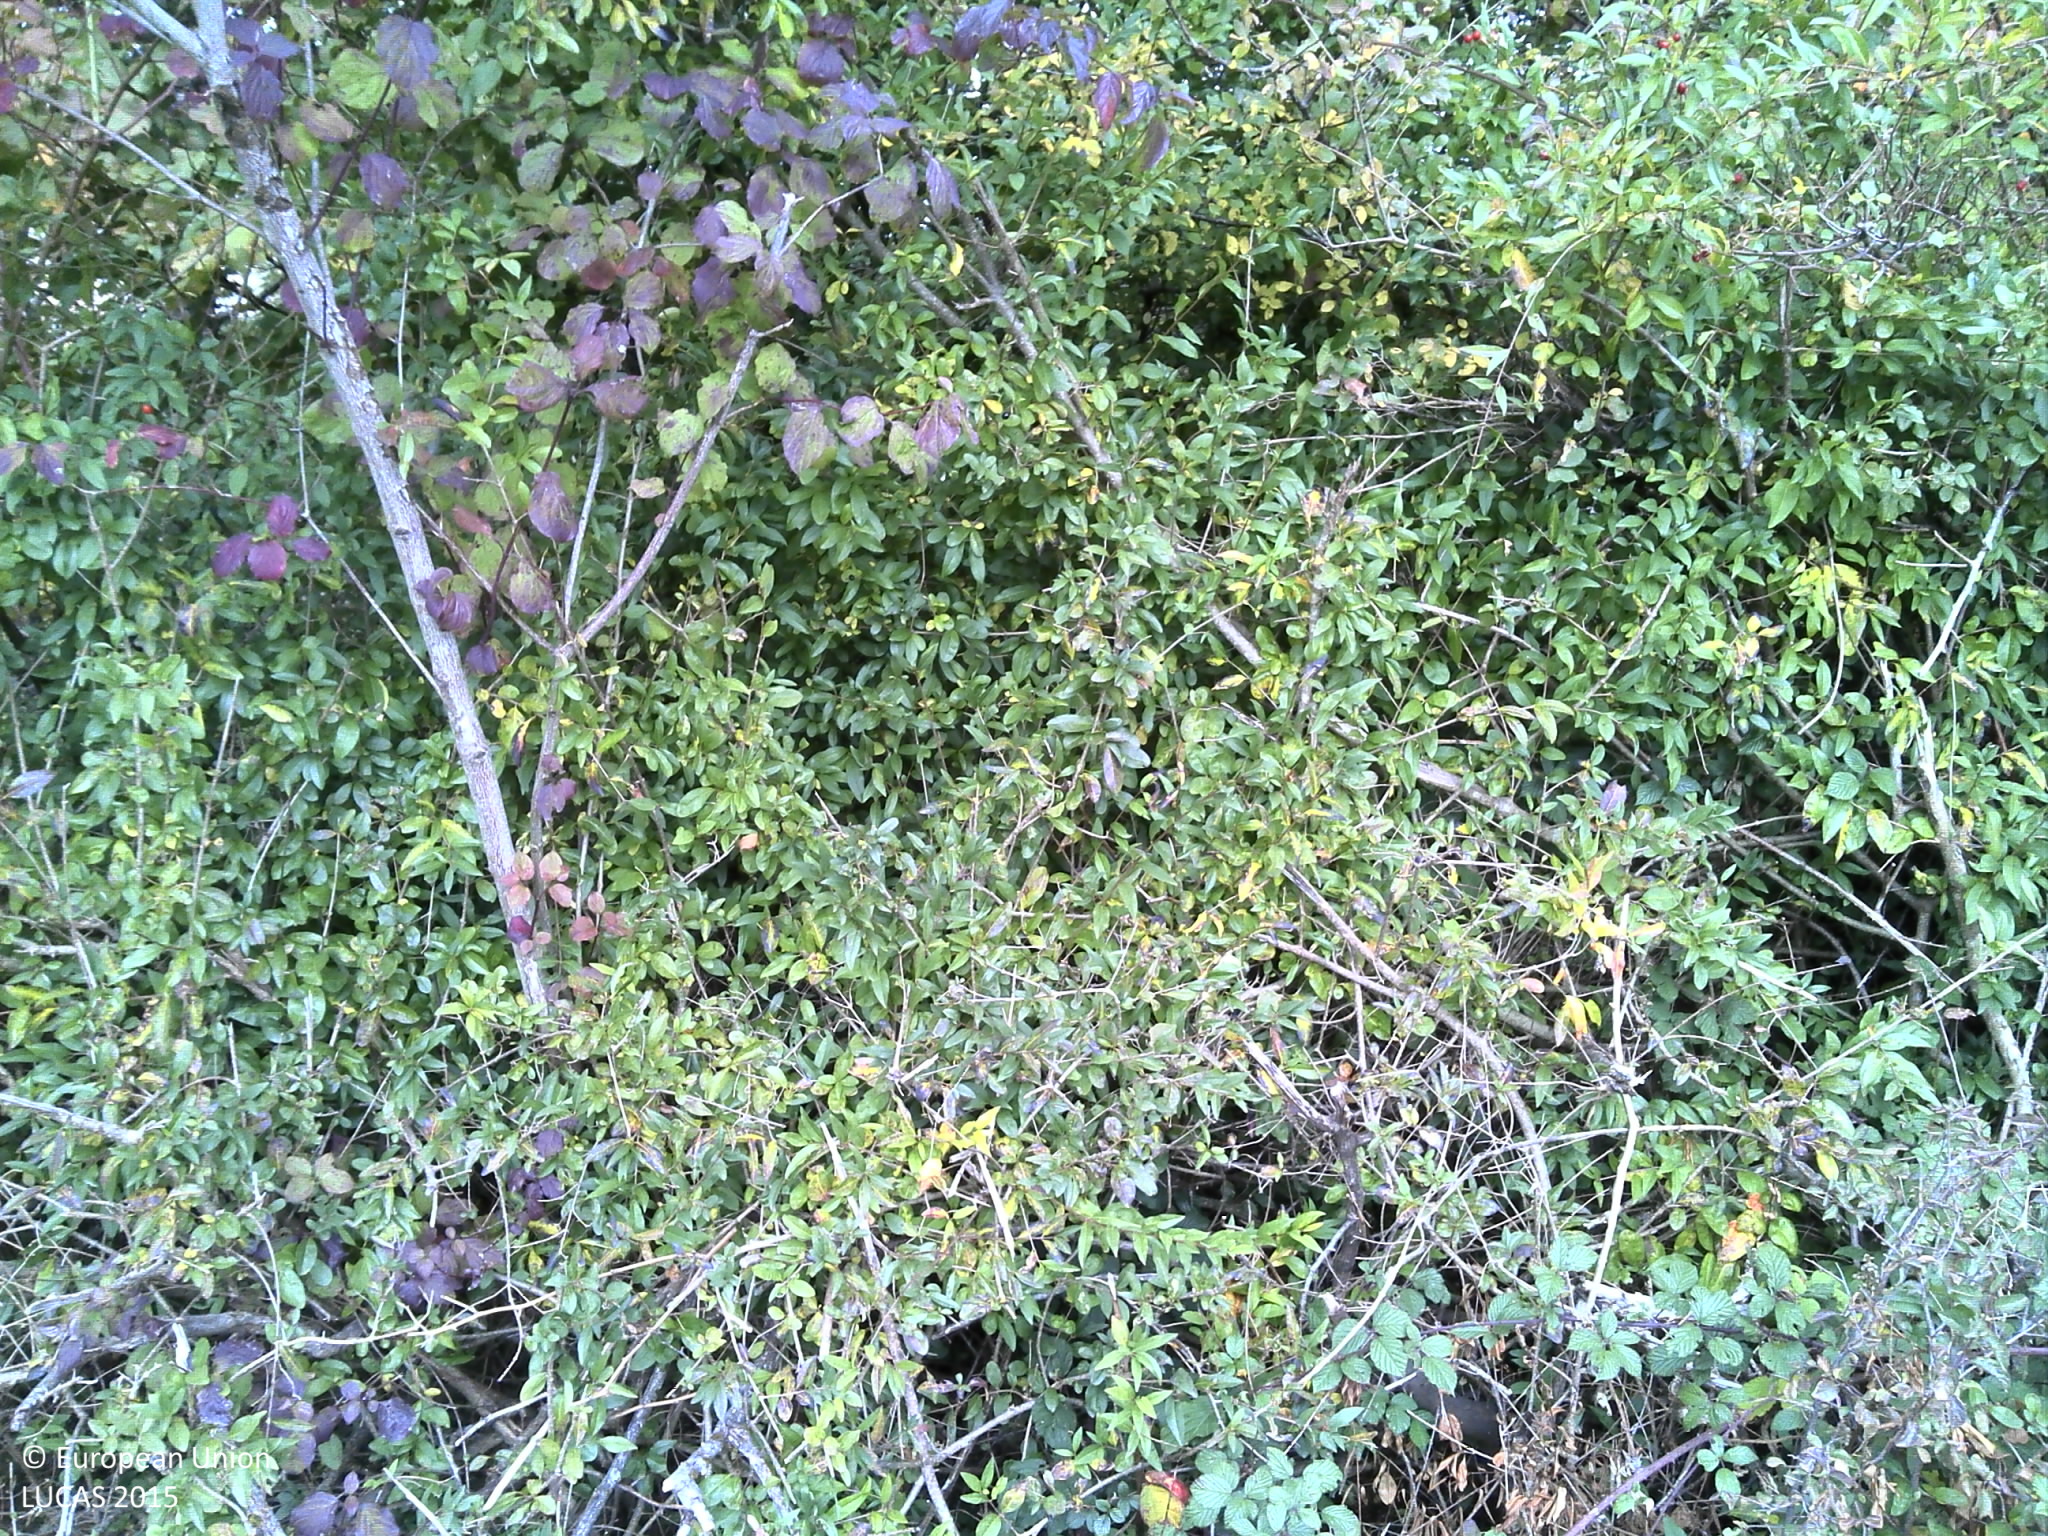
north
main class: Grassland
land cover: Grassland without tree/shrub cover
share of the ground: > 75 %
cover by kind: herbaceous plants 100 %
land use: Agriculture (excluding fallow land and kitchen gardens)
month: October
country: FR
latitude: 46.3520
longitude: 6.0917
